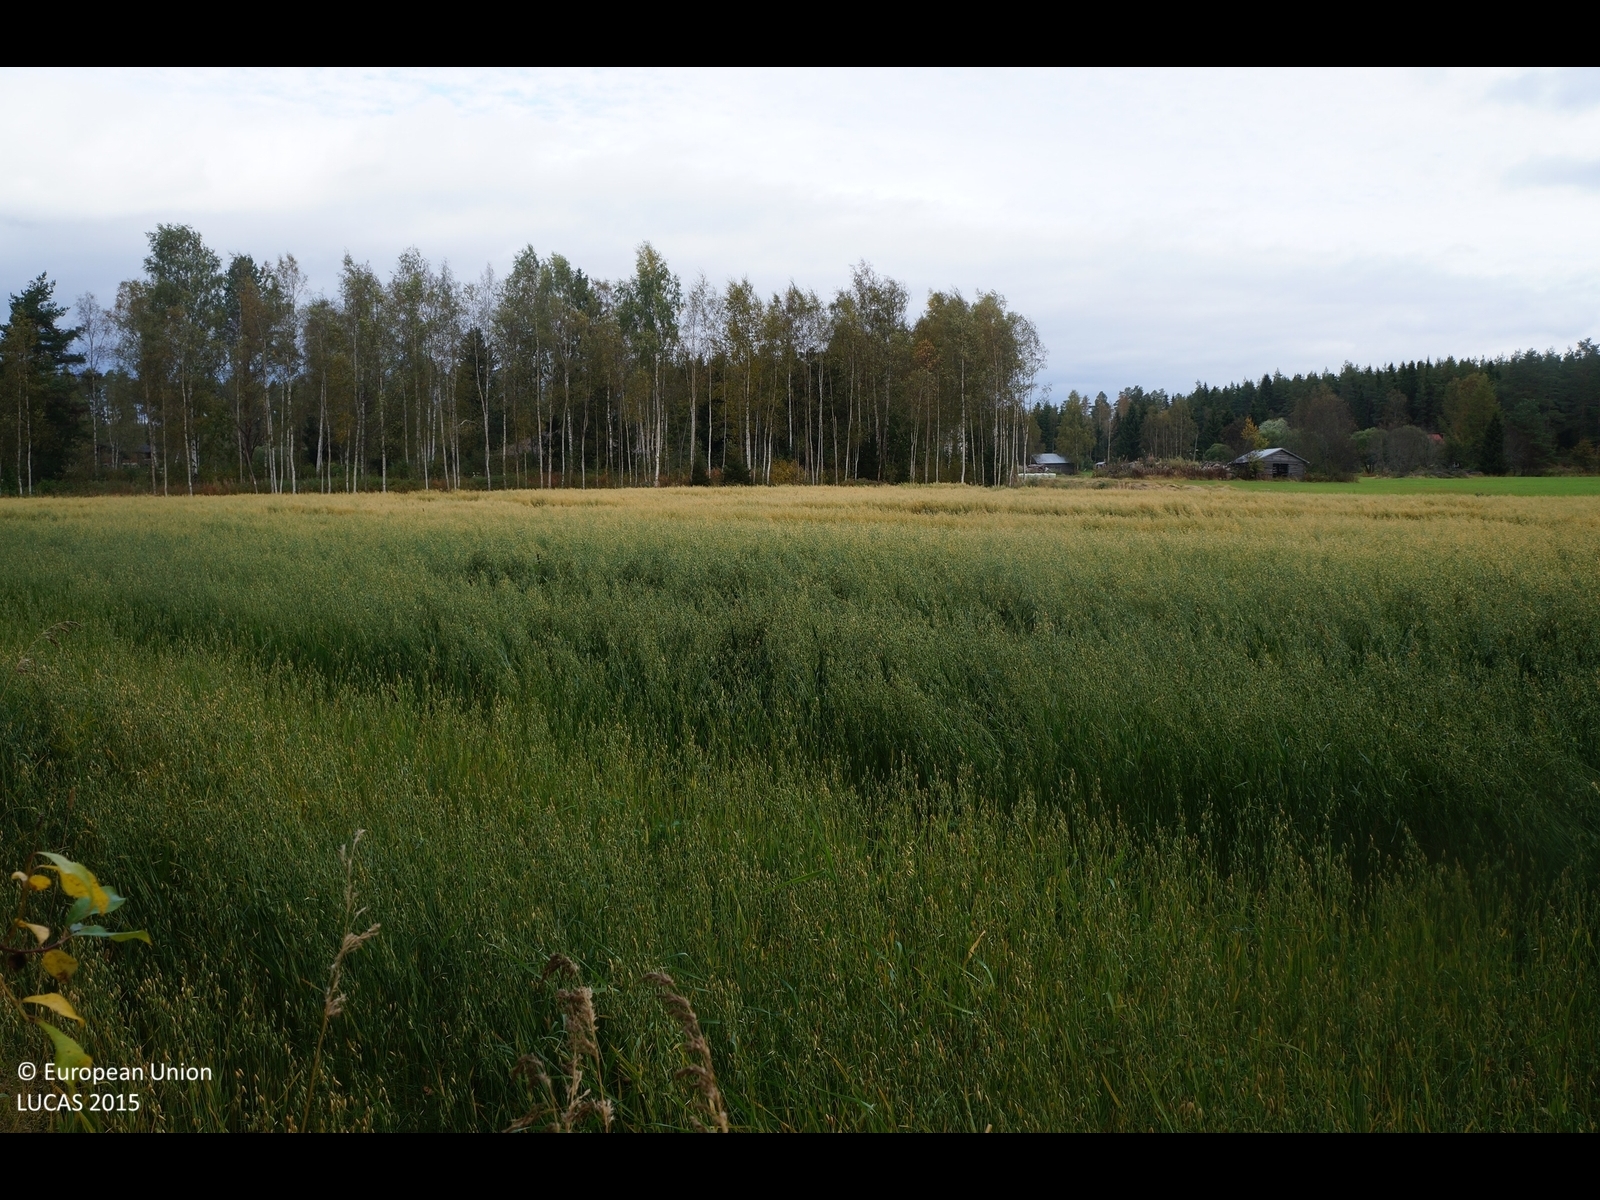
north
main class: Cropland
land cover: Oats
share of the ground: > 75 %
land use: Agriculture (excluding fallow land and kitchen gardens)
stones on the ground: < 10 %
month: September
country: FI
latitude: 63.8506
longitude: 23.3362
